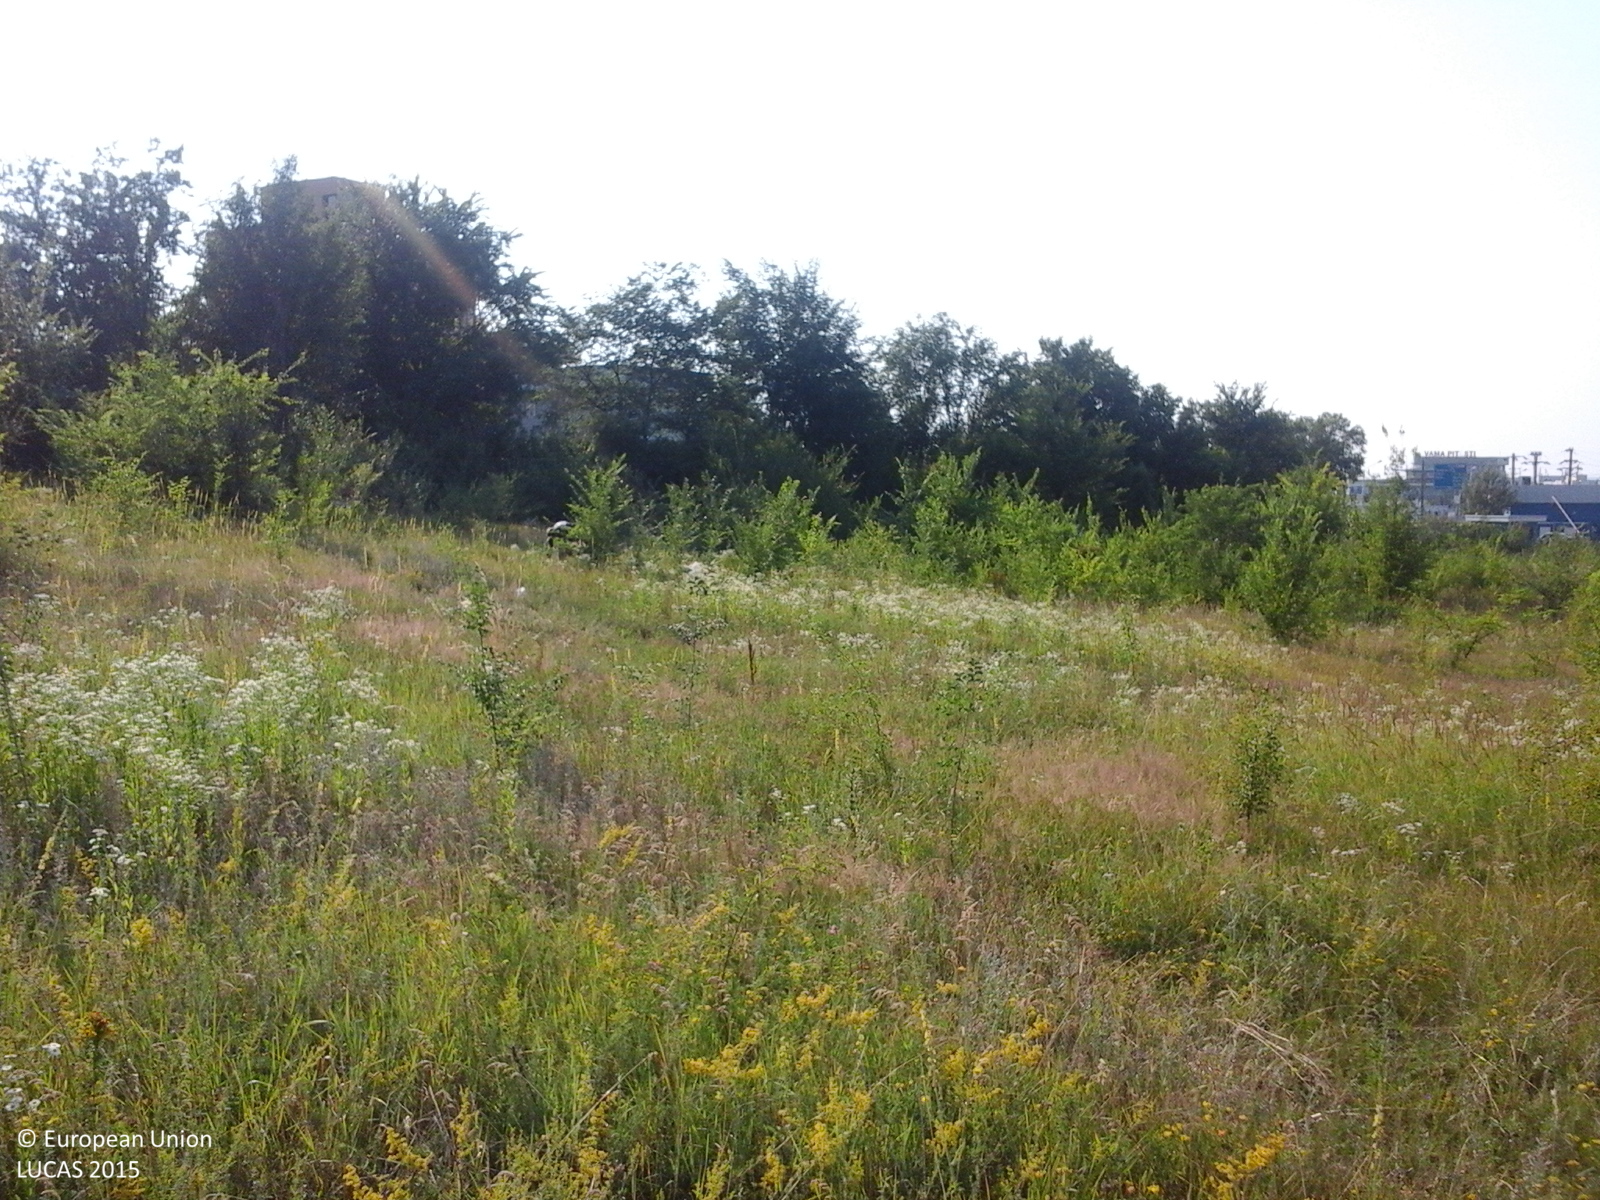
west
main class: Grassland
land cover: Grassland without tree/shrub cover
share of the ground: > 75 %
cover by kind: herbaceous plants 100 %
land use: Semi-natural and natural areas not in use
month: July
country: RO
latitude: 44.8219
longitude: 24.9169
